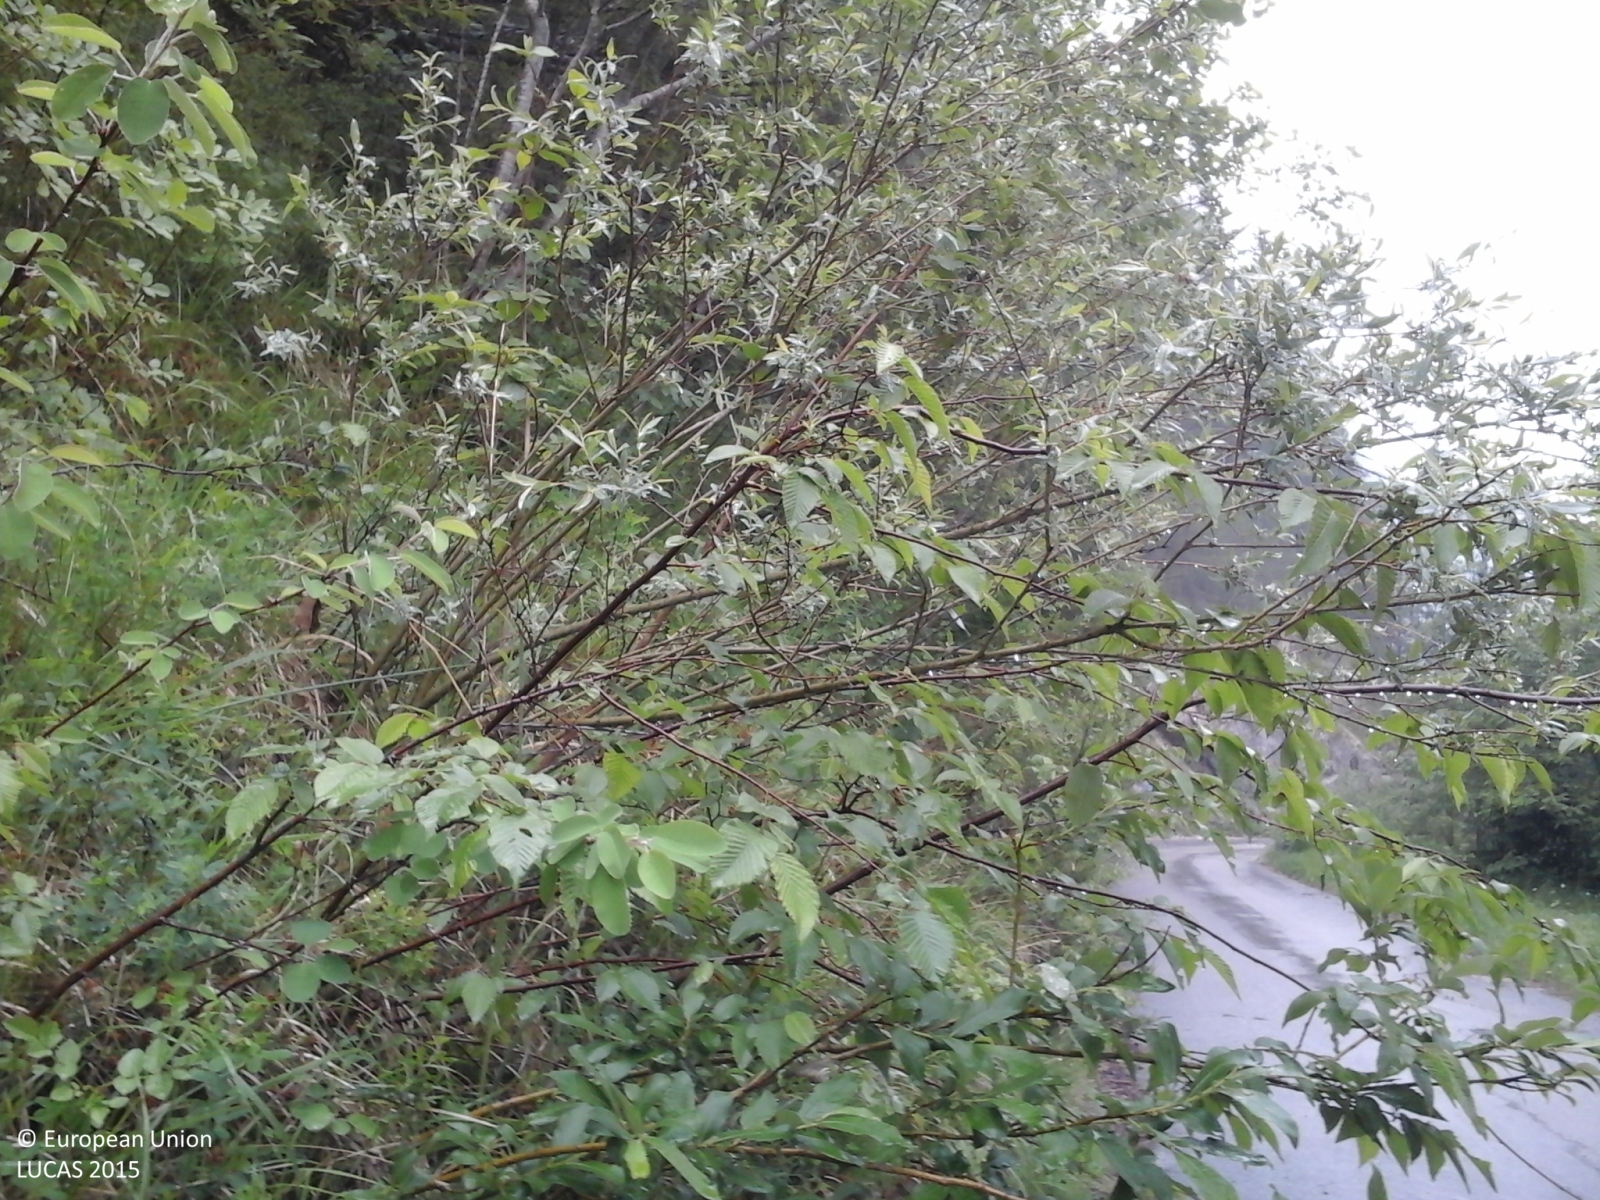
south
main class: Woodland
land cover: Pine dominated coniferous woodland
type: alpine coniferous forest
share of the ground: > 75 %
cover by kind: coniferous forest trees 100 %
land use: Forestry
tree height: > 5 m
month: May
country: IT
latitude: 46.1208
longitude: 11.7446
